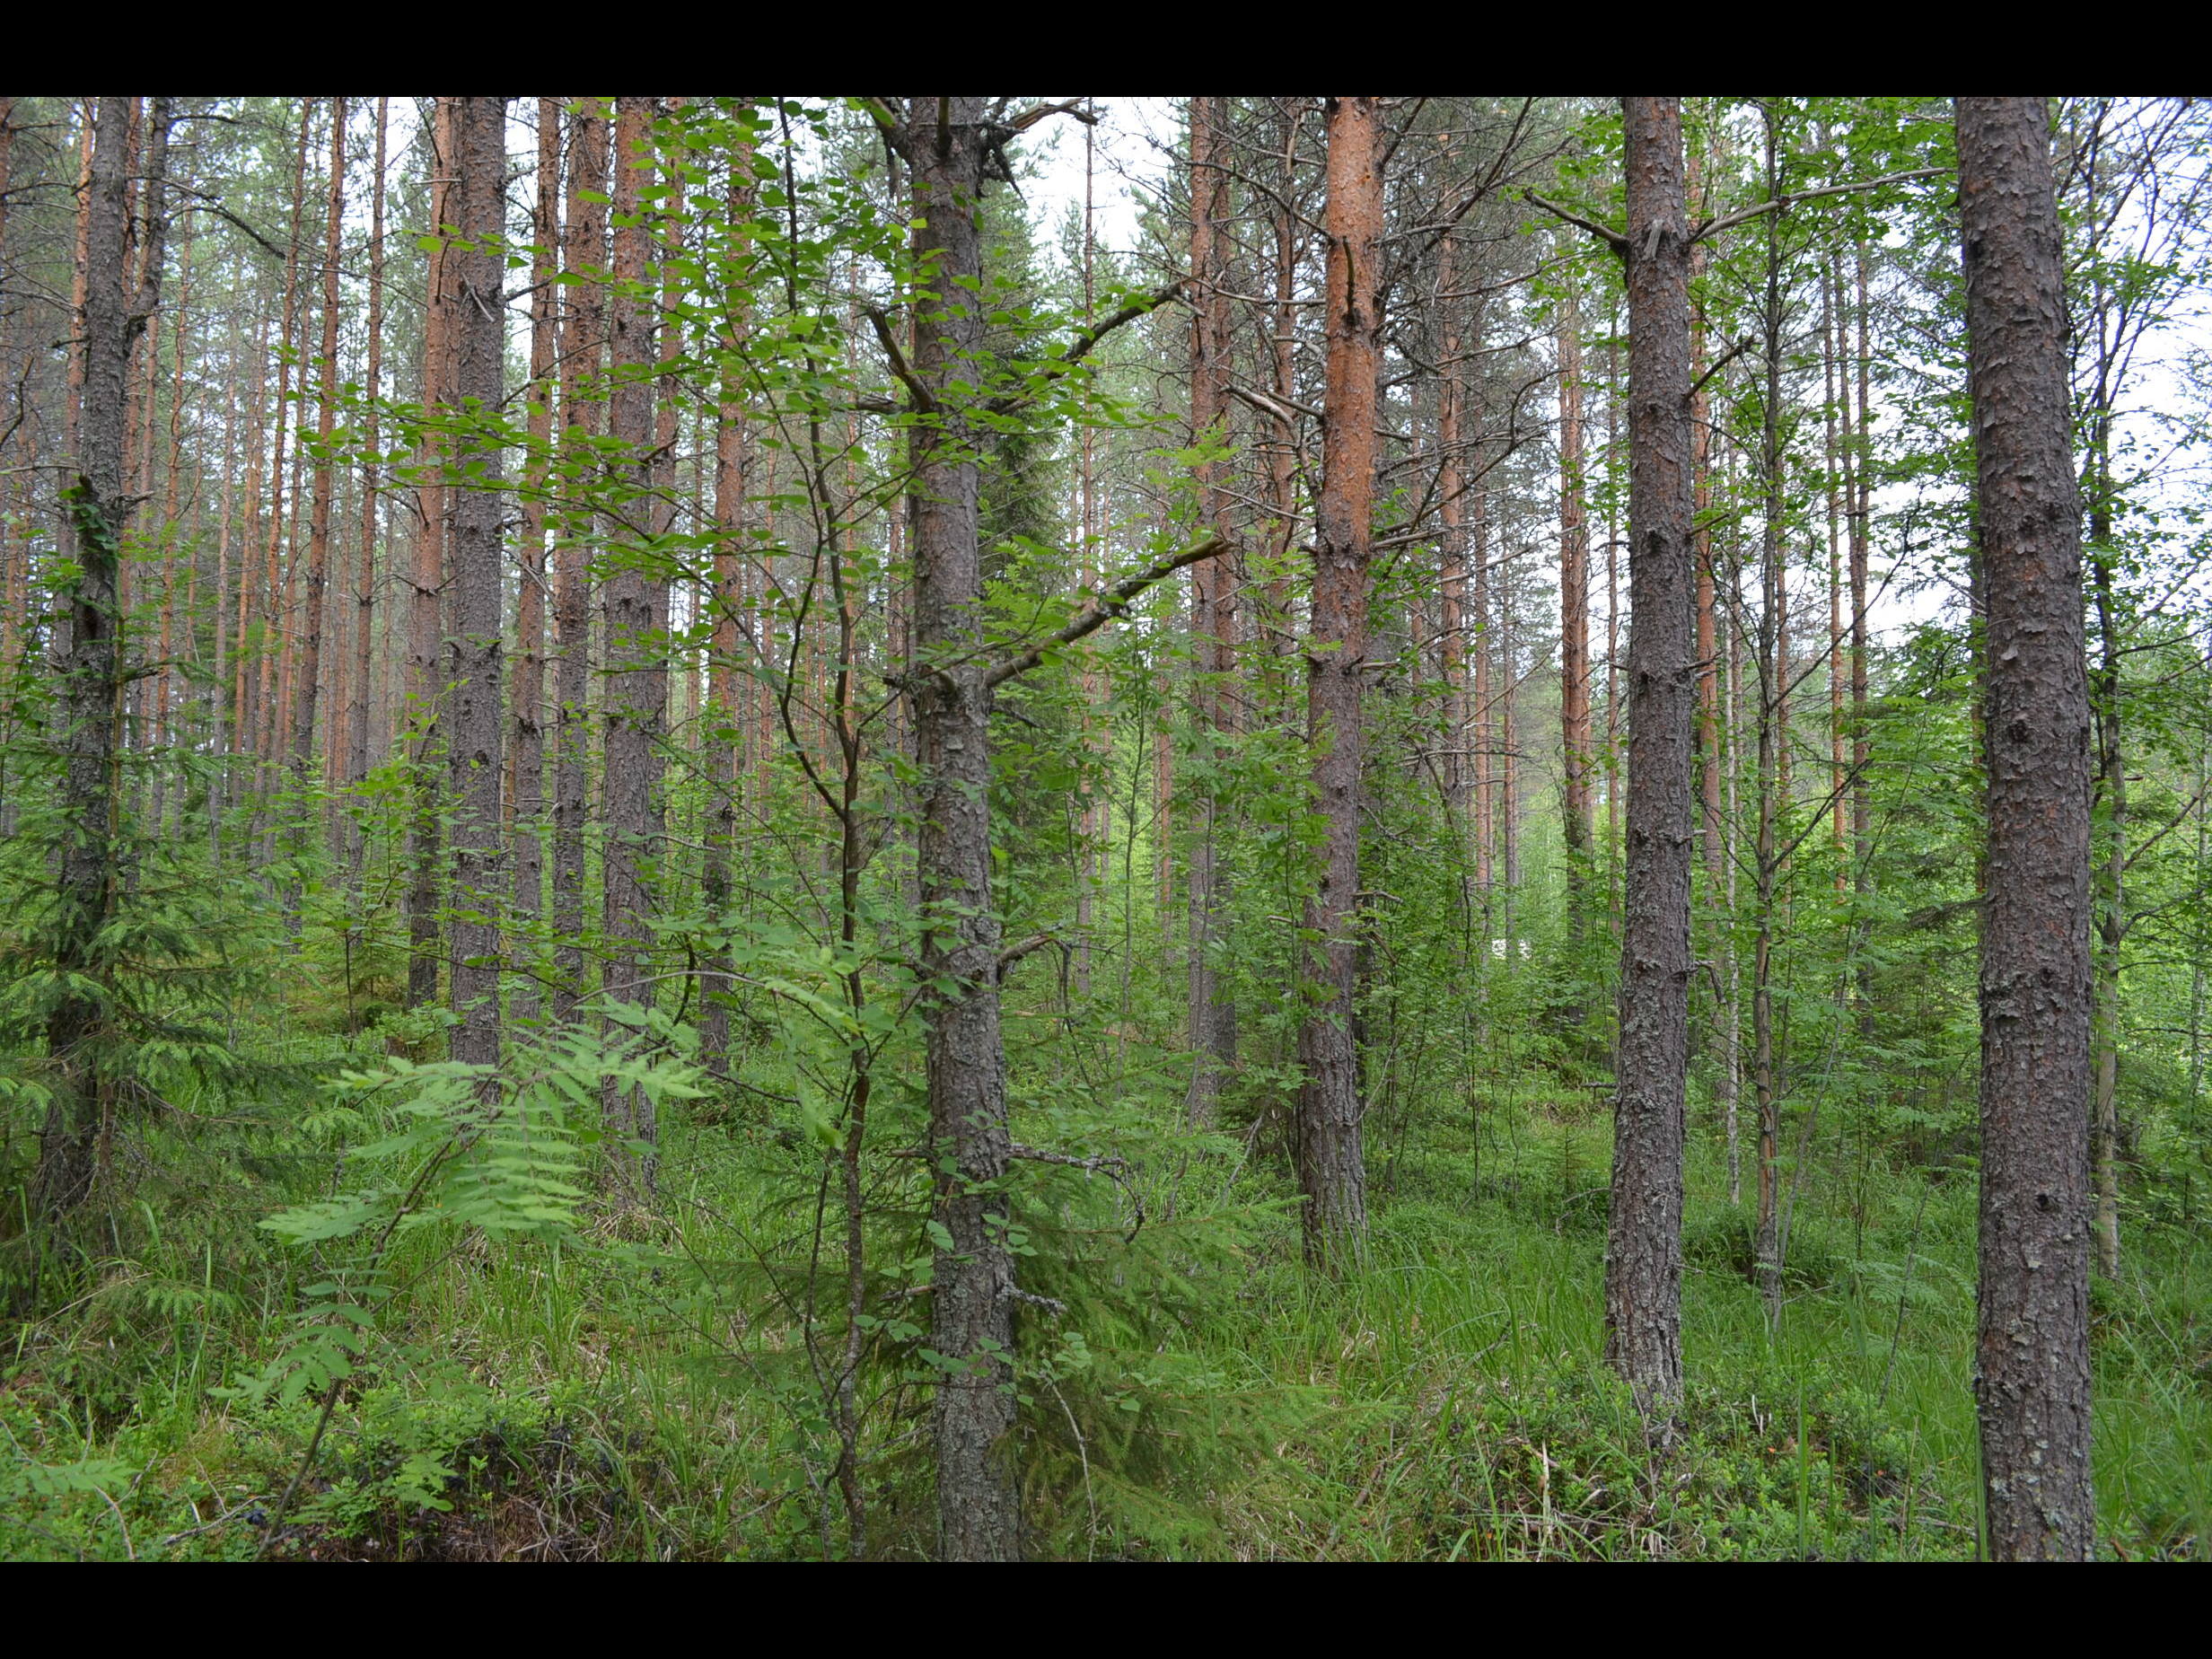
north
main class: Woodland
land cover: Pine dominated coniferous woodland
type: boreal forest
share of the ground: > 75 %
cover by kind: coniferous forest trees 75 %, shrubs 20 %, broadleaved forest trees 5 %
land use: Forestry
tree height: > 5 m
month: July
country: FI
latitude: 62.1806
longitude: 23.5390
